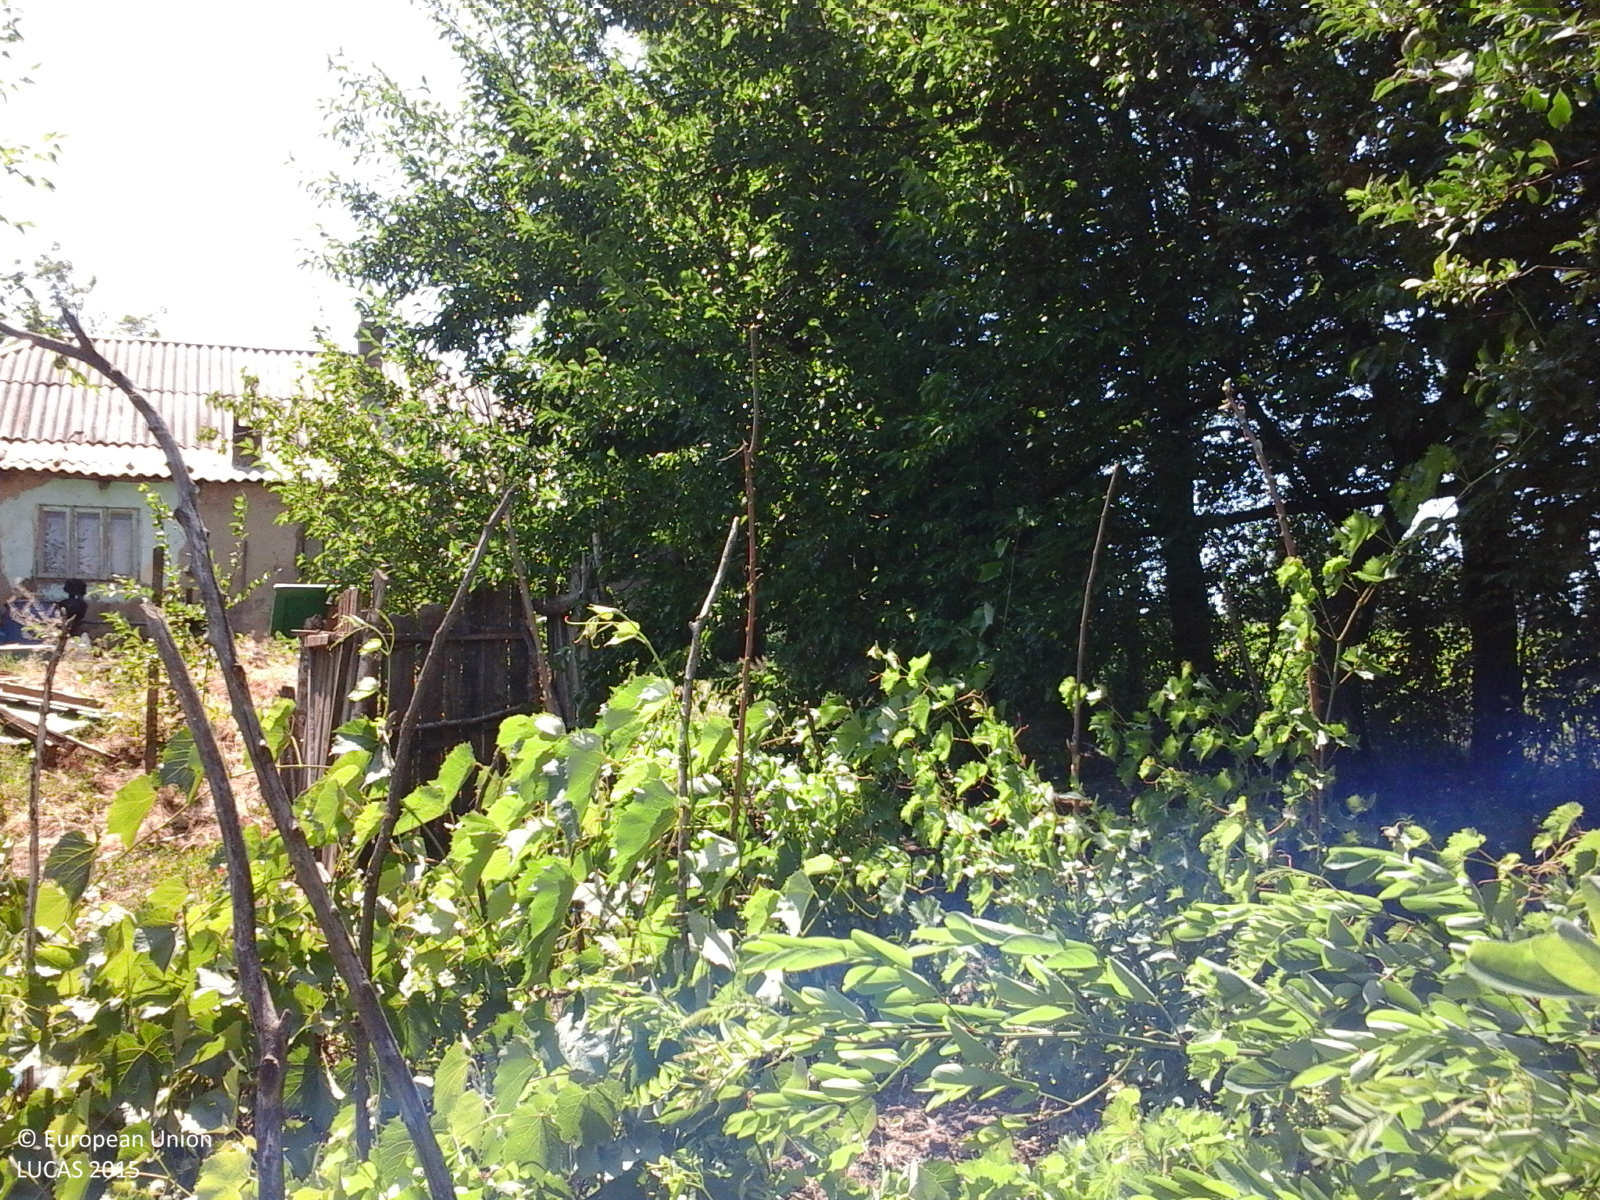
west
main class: Cropland
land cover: Vineyards
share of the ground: > 75 %
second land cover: Other bare soil
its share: > 75 %
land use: Kitchen garden
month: June
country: RO
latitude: 46.8968
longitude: 28.0753
